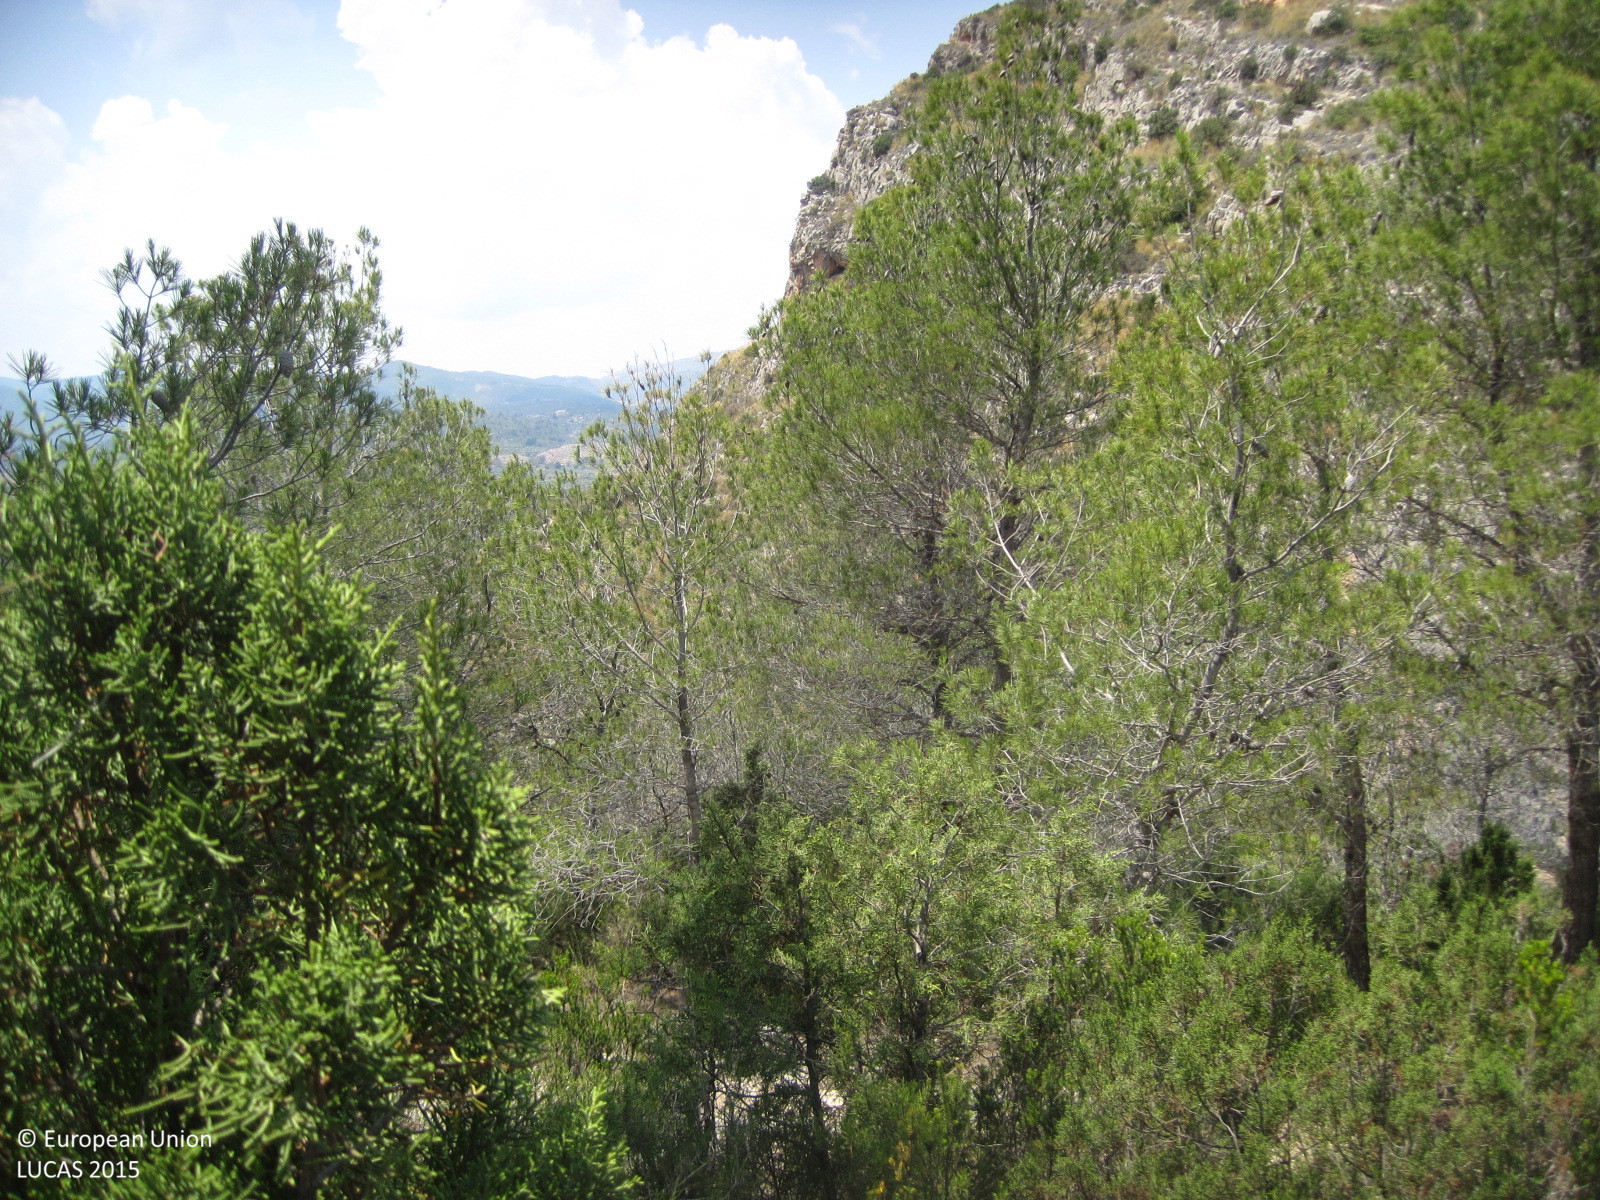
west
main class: Woodland
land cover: Pine dominated coniferous woodland
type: coniferous forest of the mediterranean region
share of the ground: 25 - 50 %
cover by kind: shrubs 45 %, coniferous forest trees 30 %, herbaceous plants 20 %, consolidated bare surface 5 %
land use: Forestry
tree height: > 5 m
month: June
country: ES
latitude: 39.7425
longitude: -0.9610
